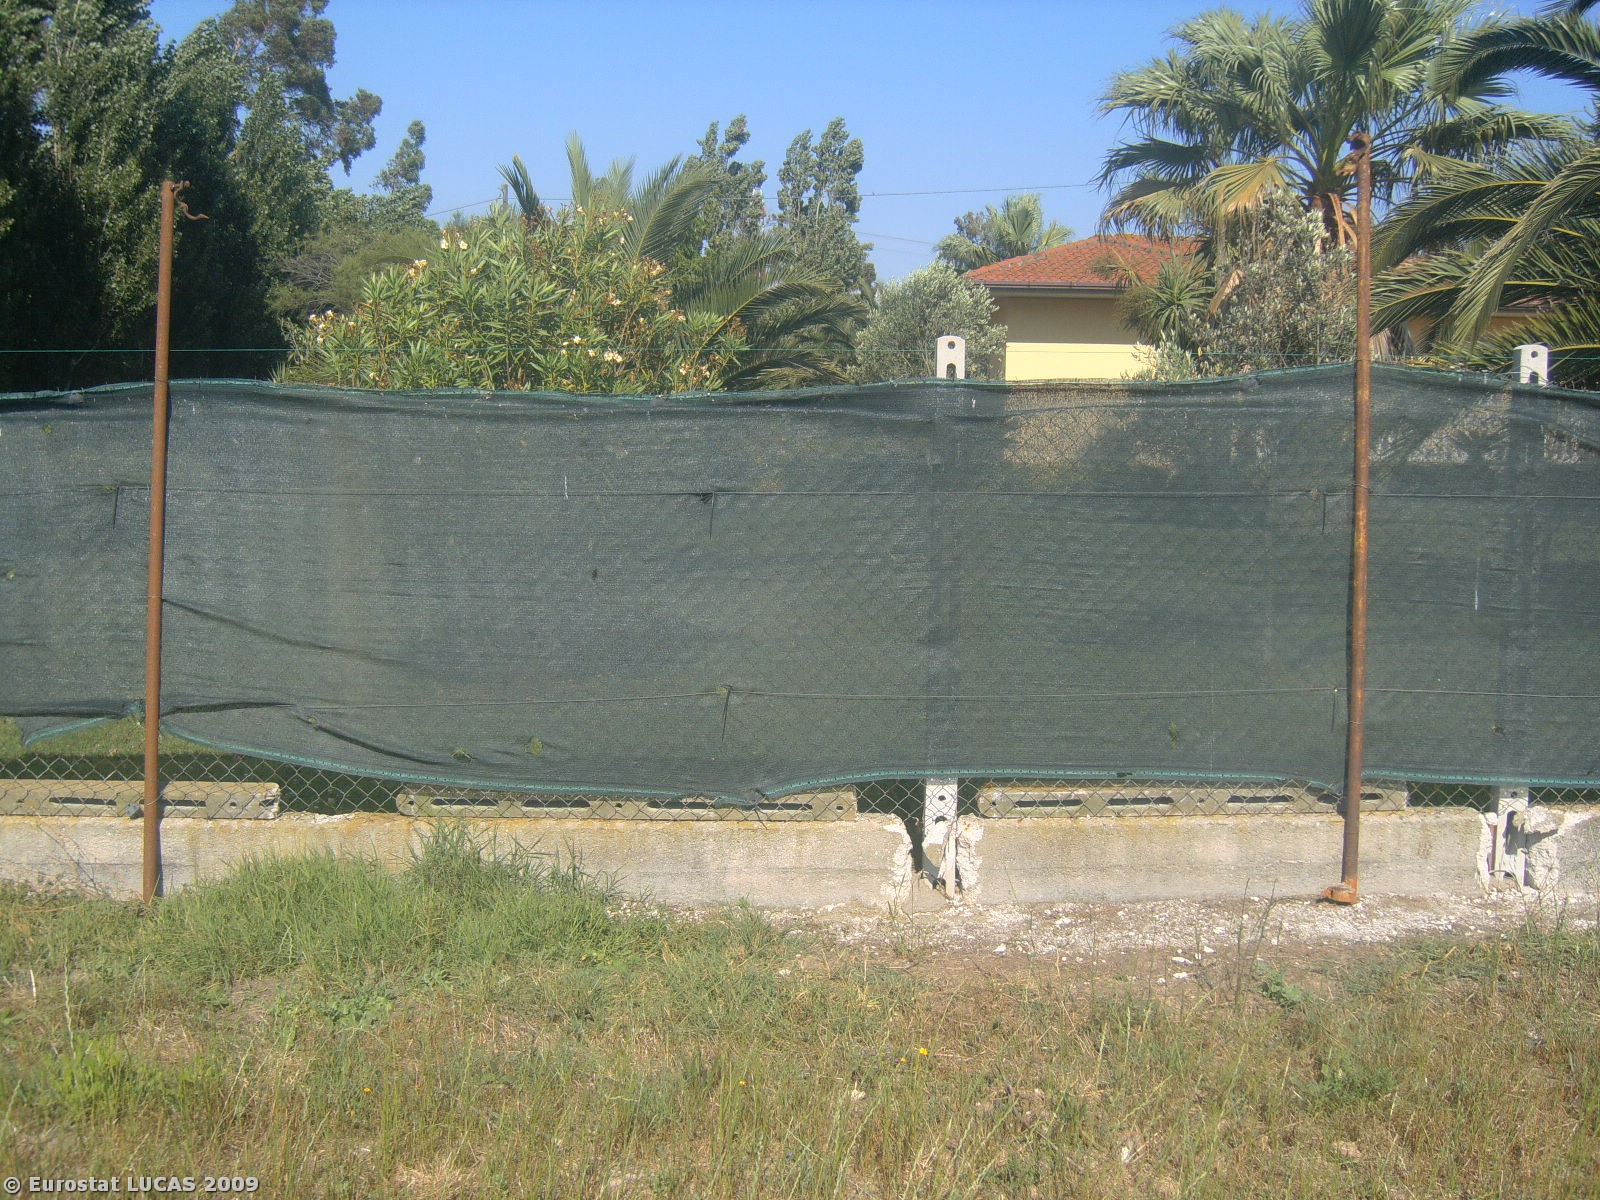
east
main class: Cropland
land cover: Temporary grasslands
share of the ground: 25 - 50 %
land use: Agriculture (excluding fallow land and kitchen gardens)
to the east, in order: Temporary grasslands; Fences; Artificial constructions in urban areas; Fences; Grassland without tree/shrub cover; Artificial constructions in urban areas; Grassland without tree/shrub cover; Fences; Electric lines; Grass margins; Ditches and canals; Grass margins; Paved roads, cycling and walking lanes; Single bushes/trees; Shrubland without tree cover; Grassland without tree/shrub cover; Vineyards; Grassland with sparse tree/shrub cover
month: June
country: IT
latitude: 41.4588
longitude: 12.7783
